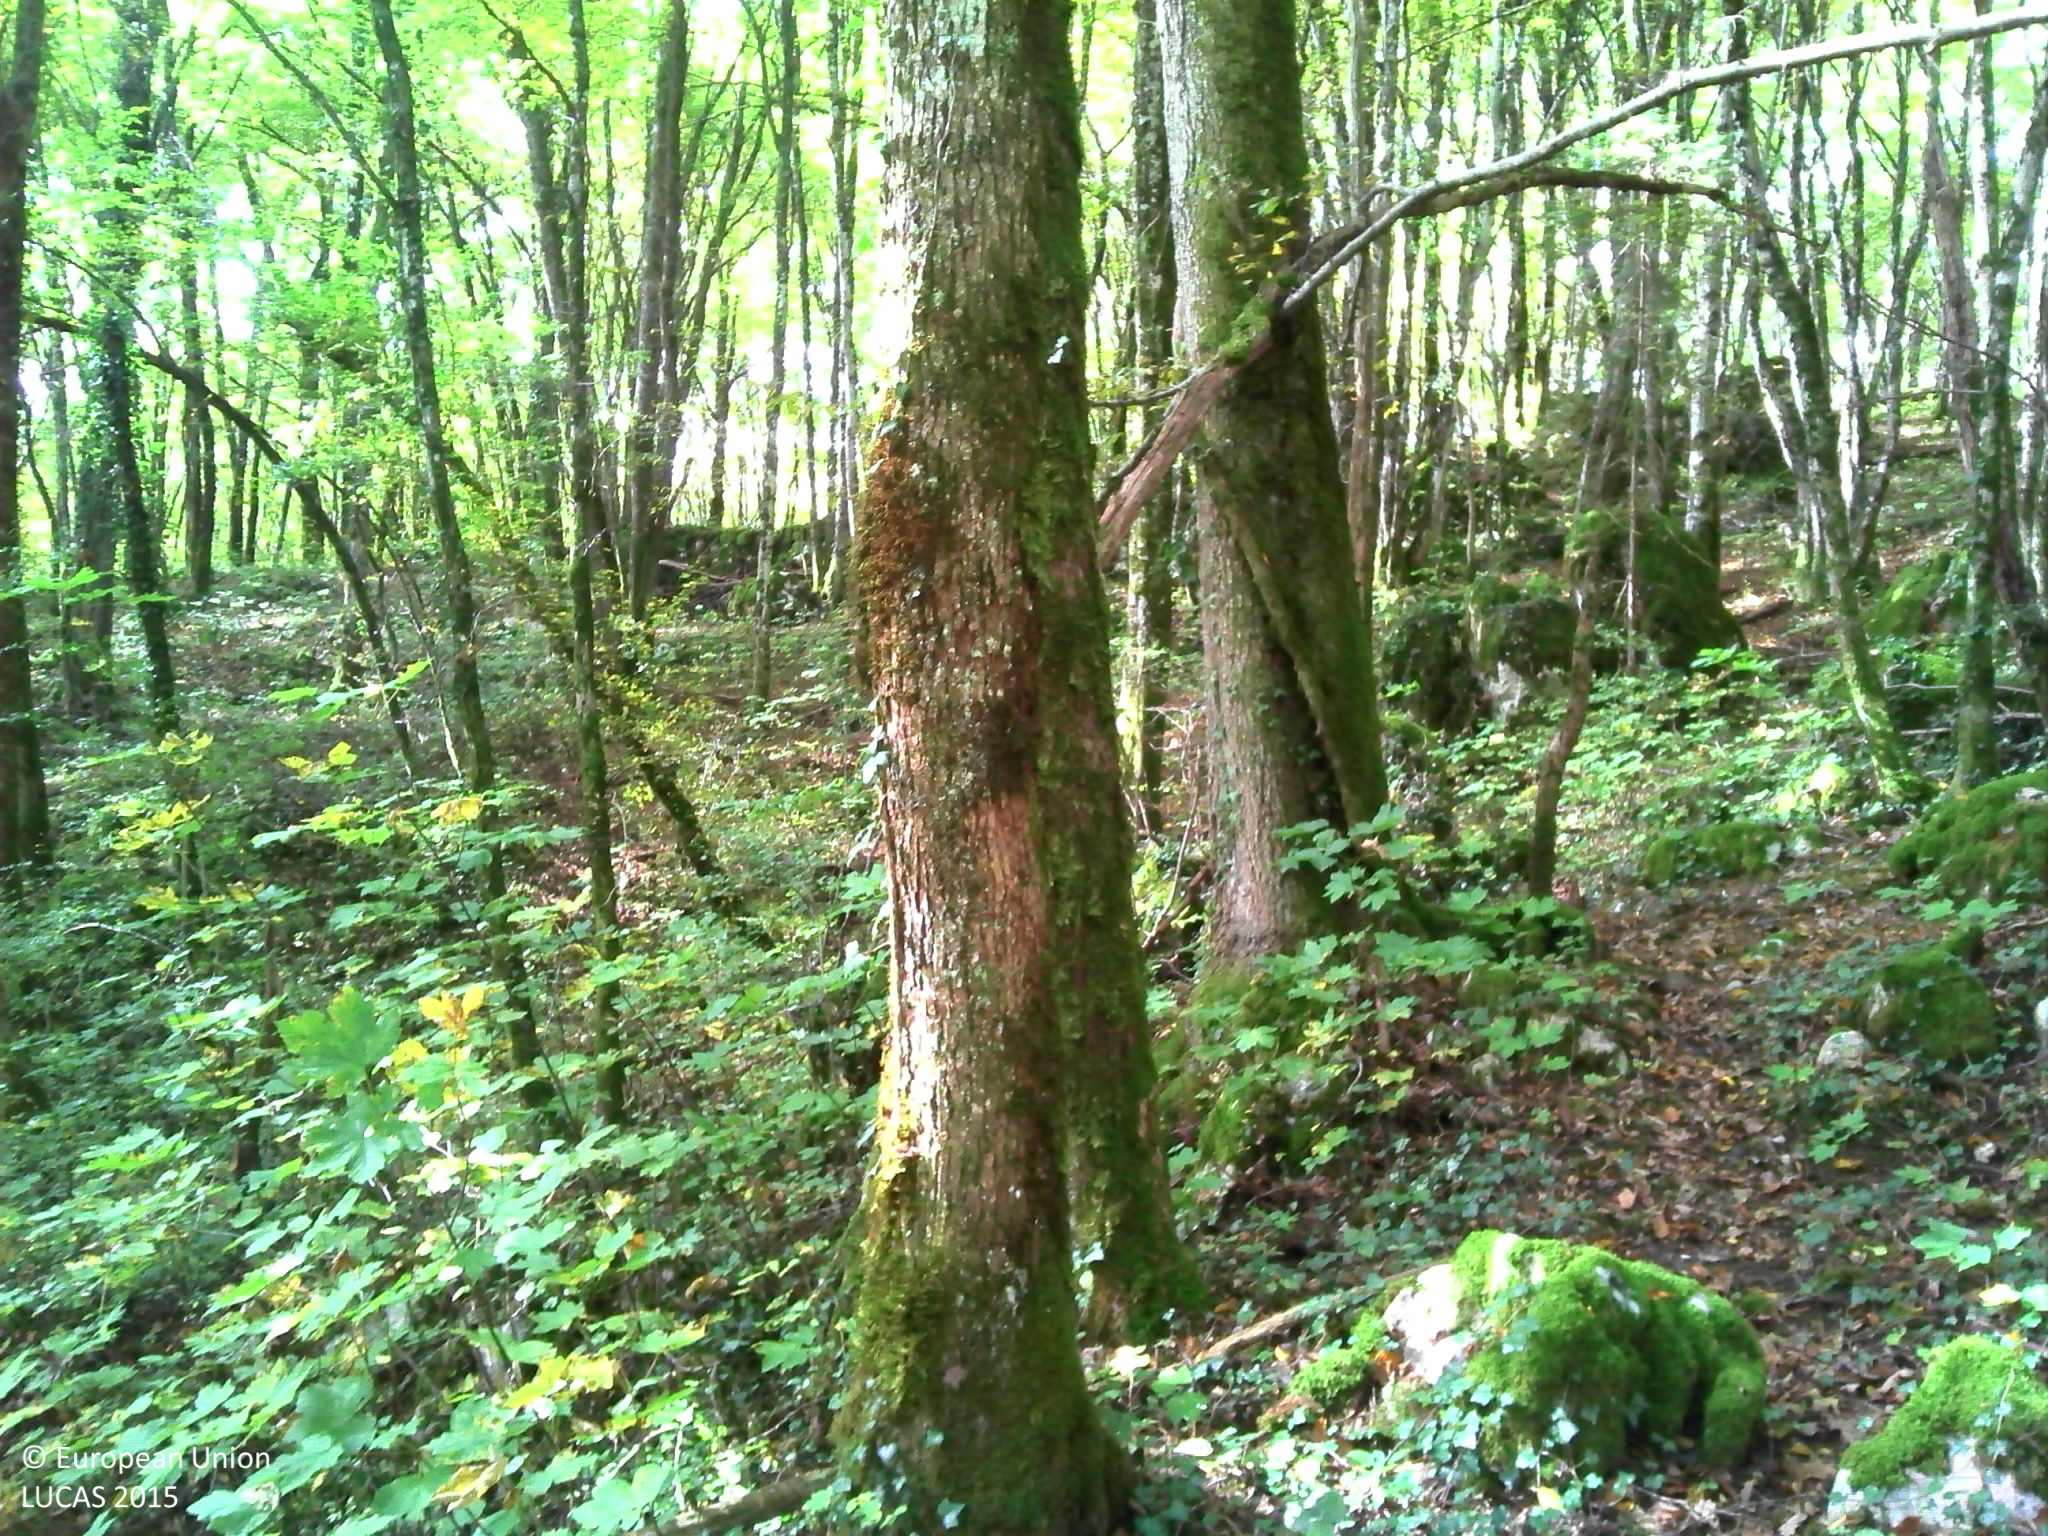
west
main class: Woodland
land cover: Broadleaved woodland
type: mesophytic deciduous forest
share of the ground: > 75 %
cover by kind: broadleaved forest trees 90 %, lichens and mosses 5 %, consolidated bare surface 5 %
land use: Forestry
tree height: > 5 m
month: October
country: FR
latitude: 47.0436
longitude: 6.2774
